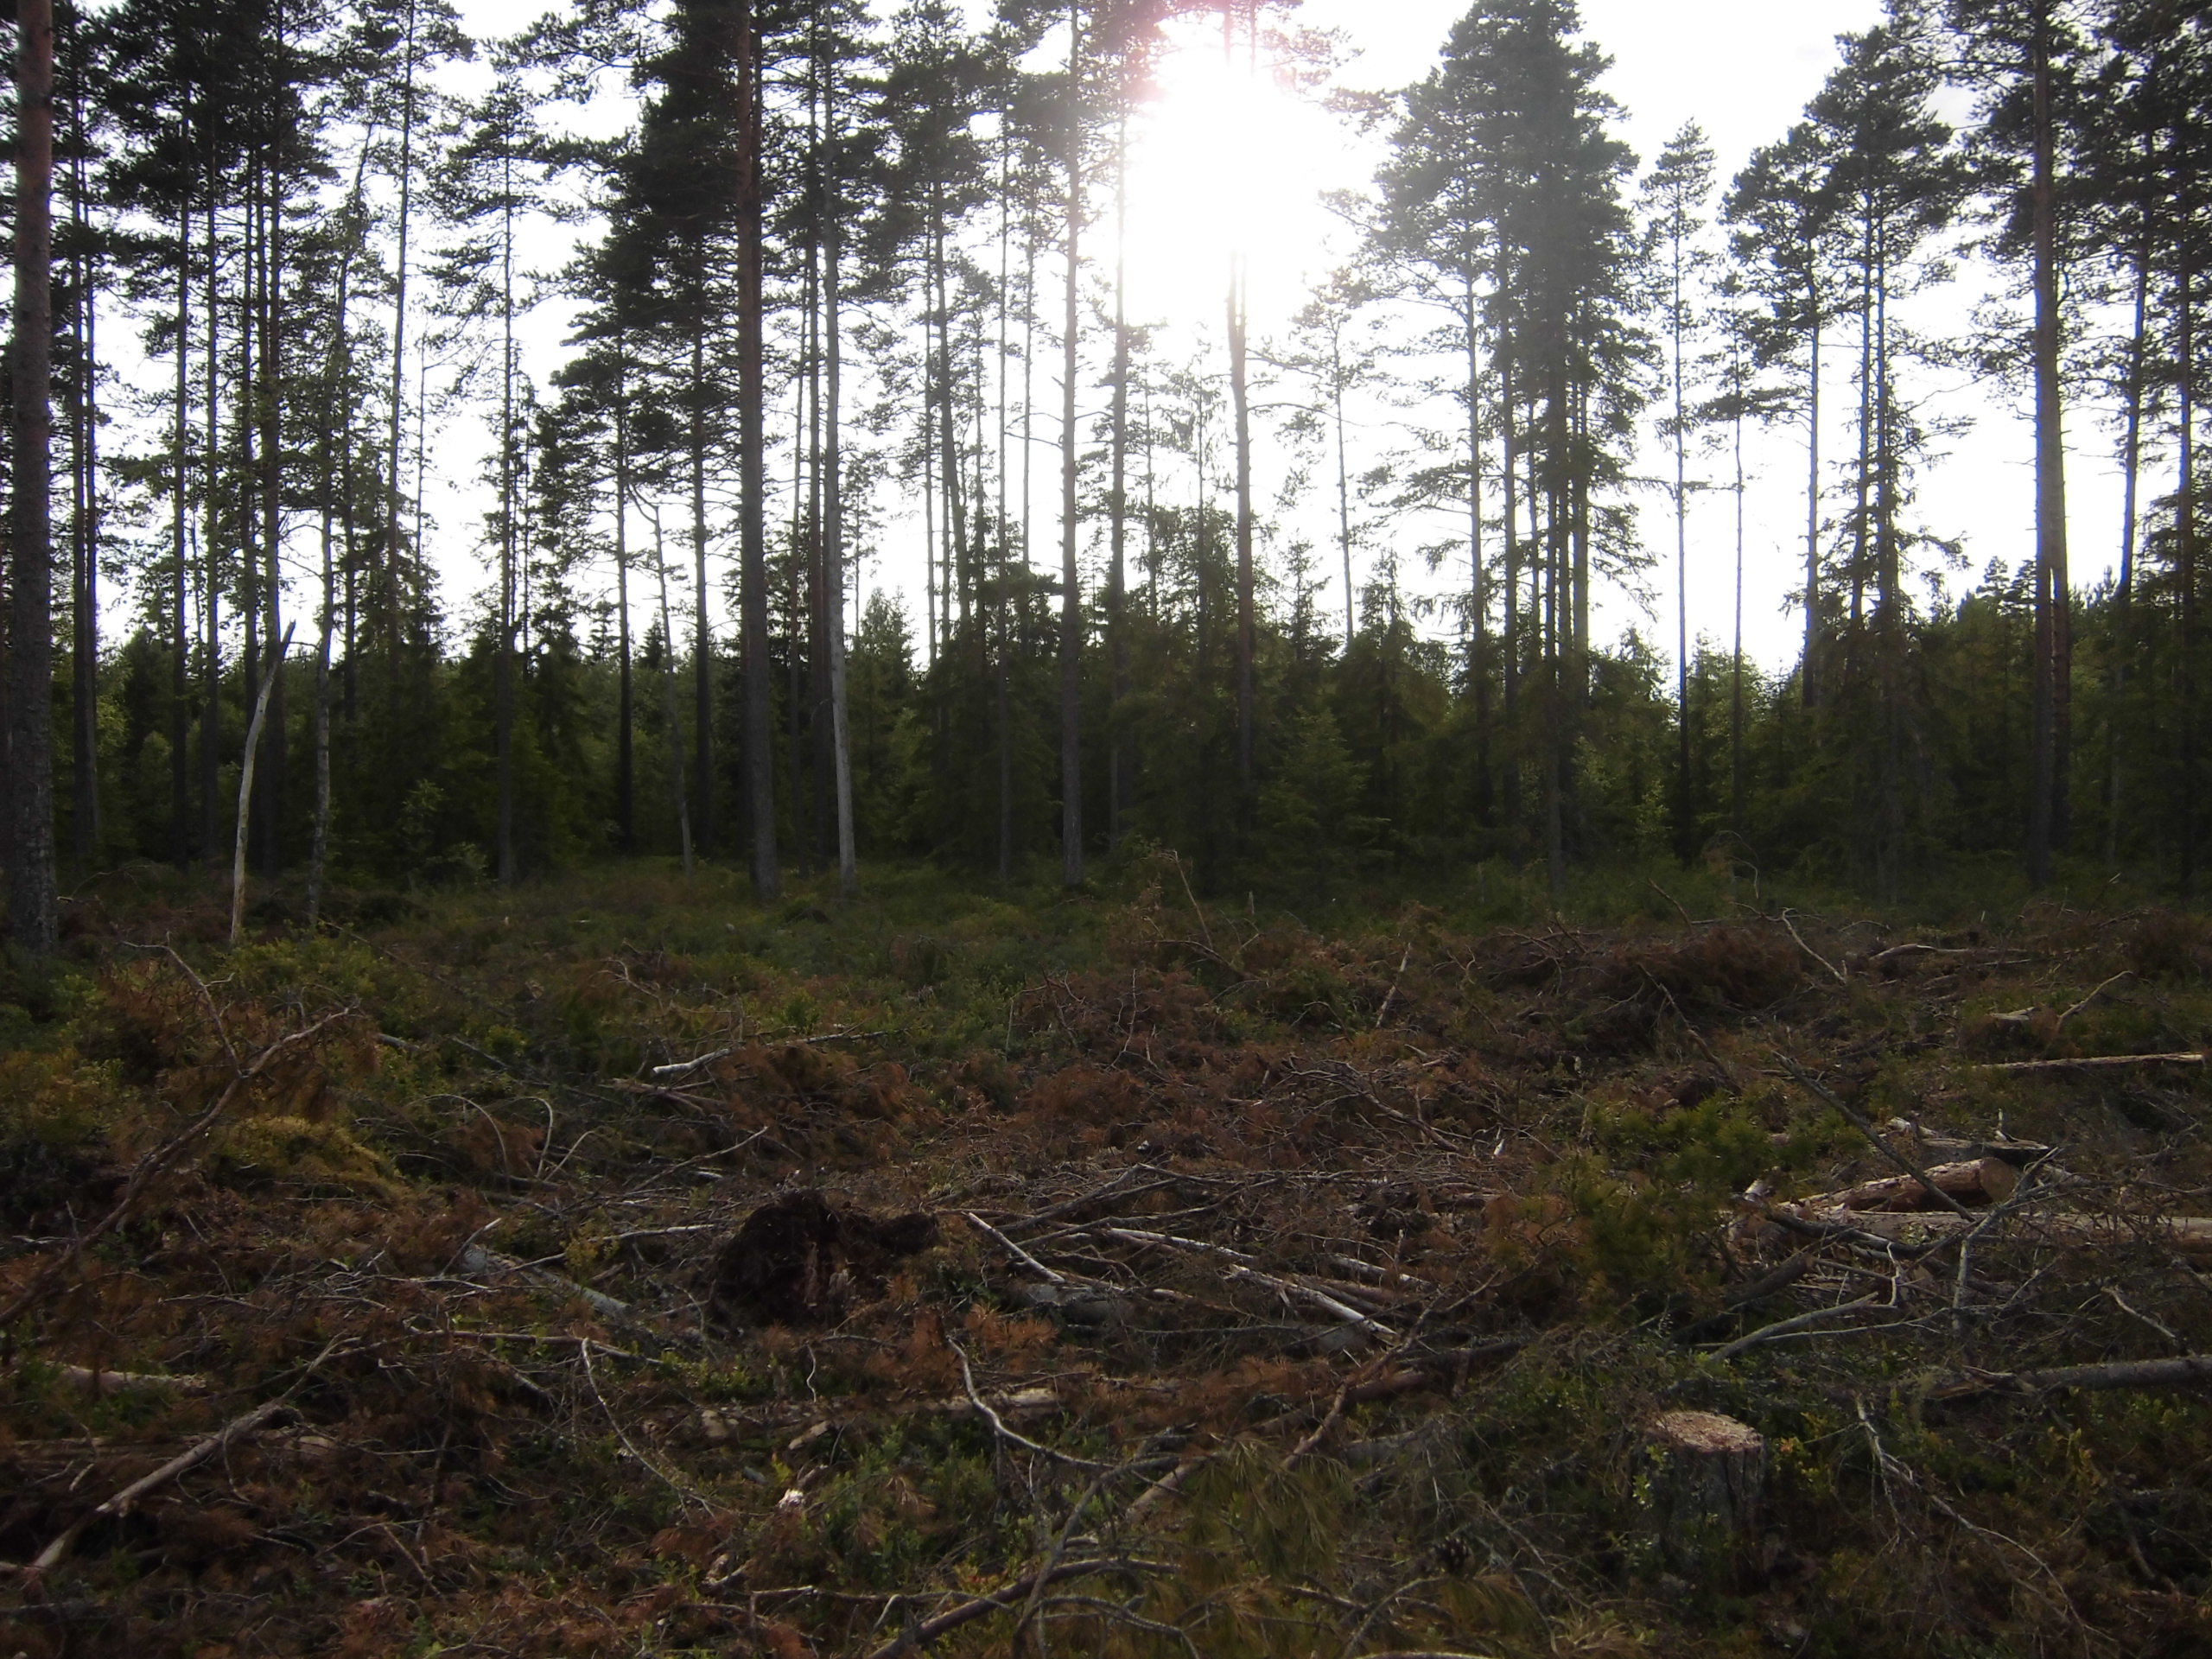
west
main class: Shrubland
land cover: Shrubland with sparse tree cover
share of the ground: 25 - 50 %
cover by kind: shrubs 35 %, unconsolidated bare surface 30 %, lichens and mosses 20 %, herbaceous plants 10 %, coniferous forest trees 5 %
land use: Forestry
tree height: > 5 m
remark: Clear cut
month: July
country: SE
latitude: 57.4858
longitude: 14.7833
